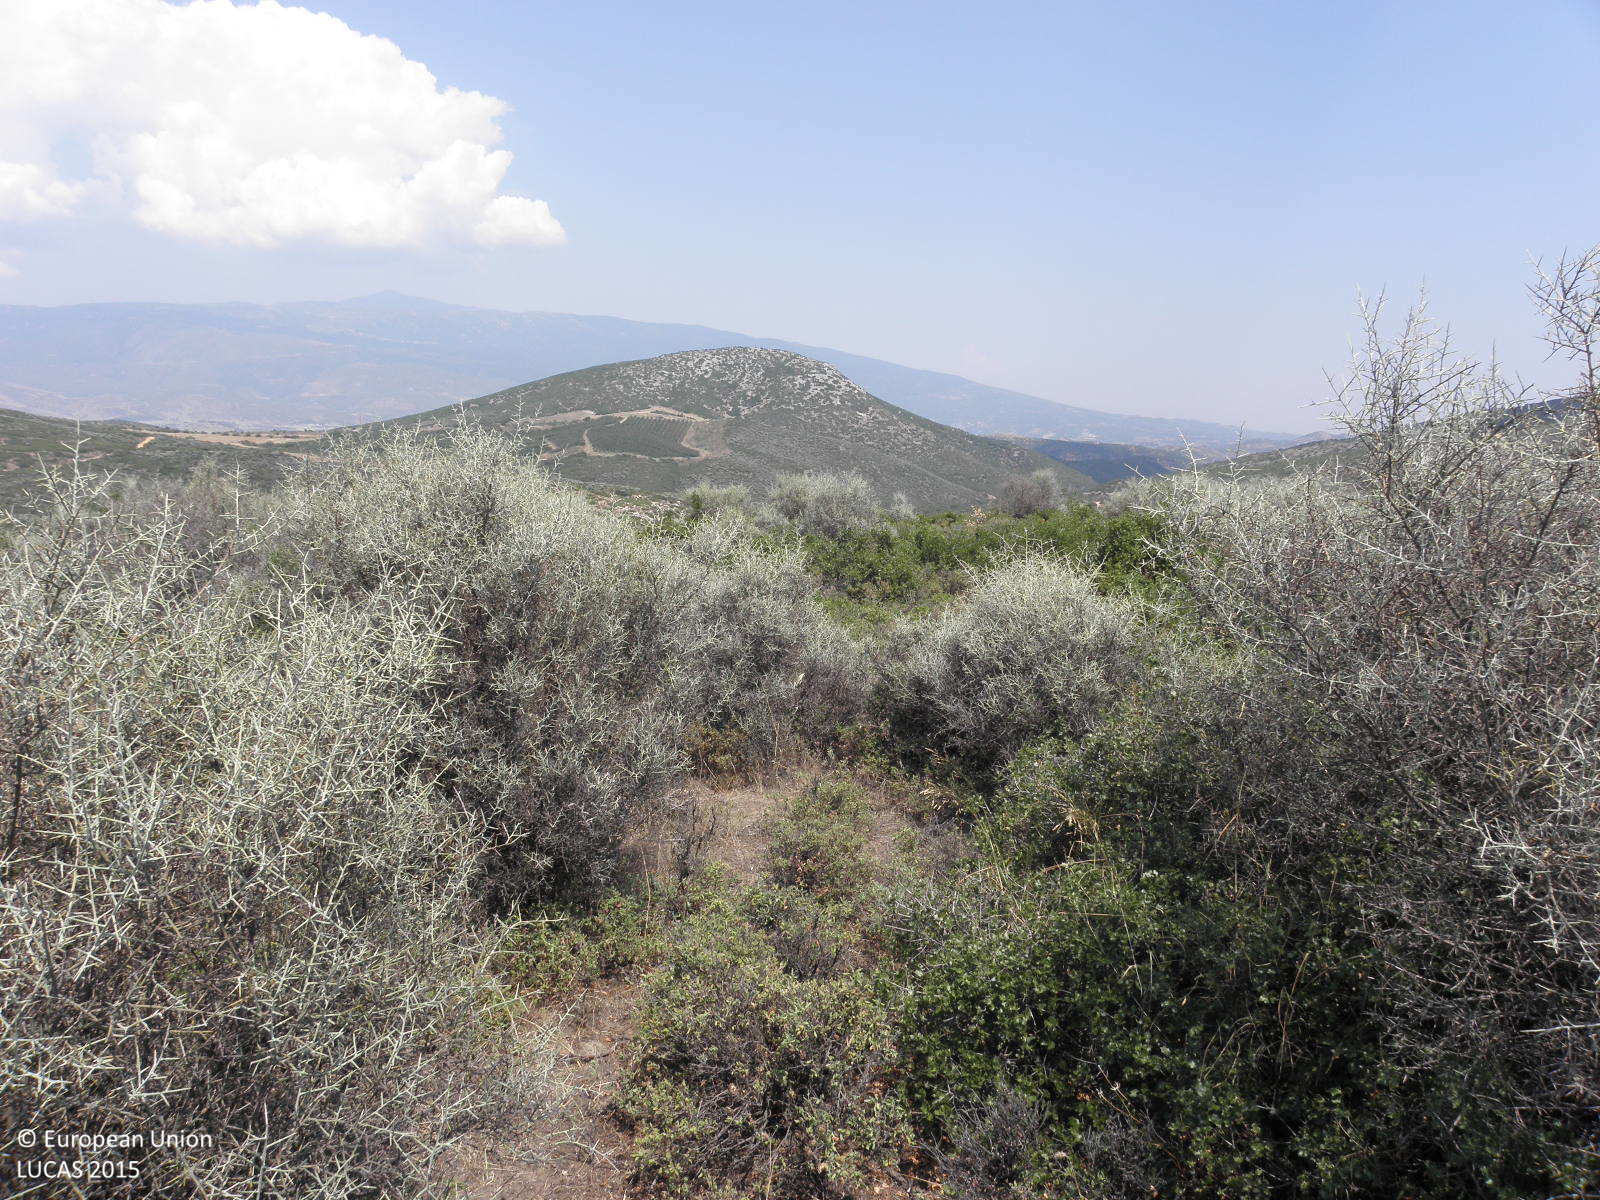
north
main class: Shrubland
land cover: Shrubland without tree cover
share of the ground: > 75 %
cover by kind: shrubs 90 %, herbaceous plants 10 %
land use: Agriculture (excluding fallow land and kitchen gardens)
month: August
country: GR
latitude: 39.6181
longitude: 22.7245
